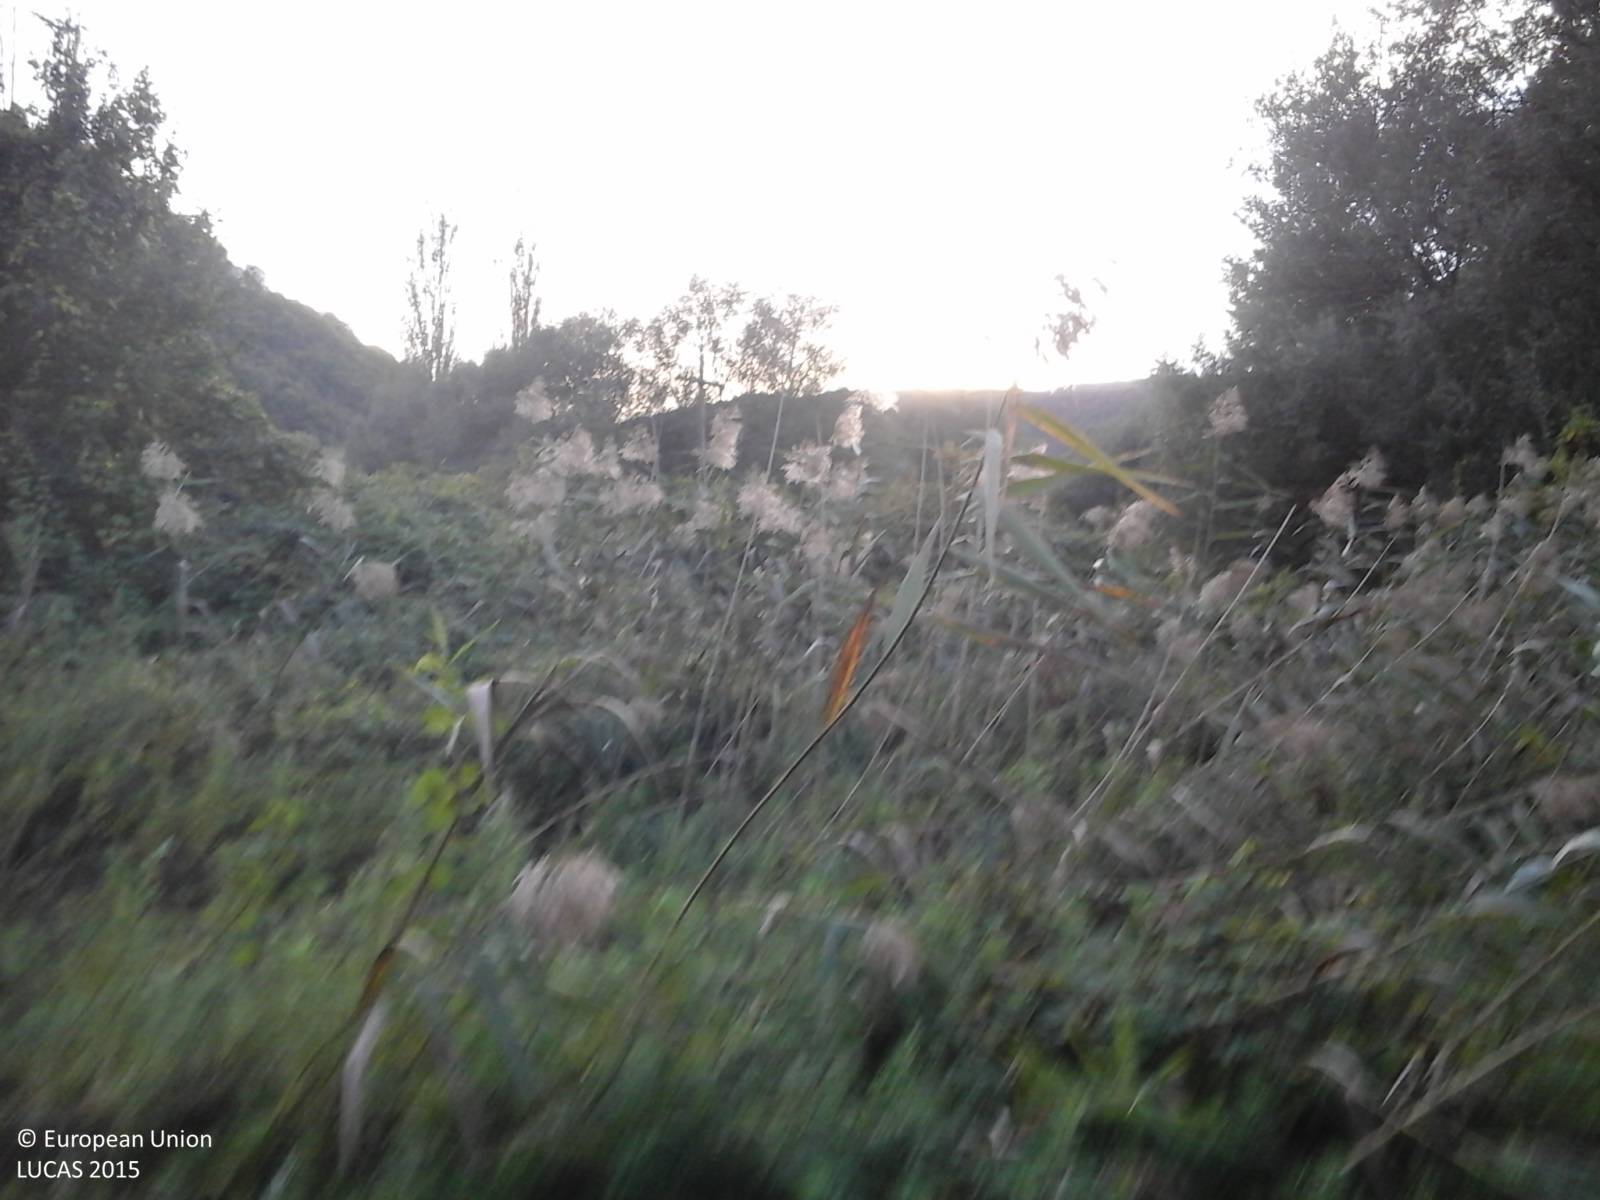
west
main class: Shrubland
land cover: Shrubland with sparse tree cover
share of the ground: 50 - 75 %
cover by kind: shrubs 70 %, herbaceous plants 25 %, broadleaved forest trees 5 %
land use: Abandoned areas
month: October
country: IT
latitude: 42.8109
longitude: 12.9140
